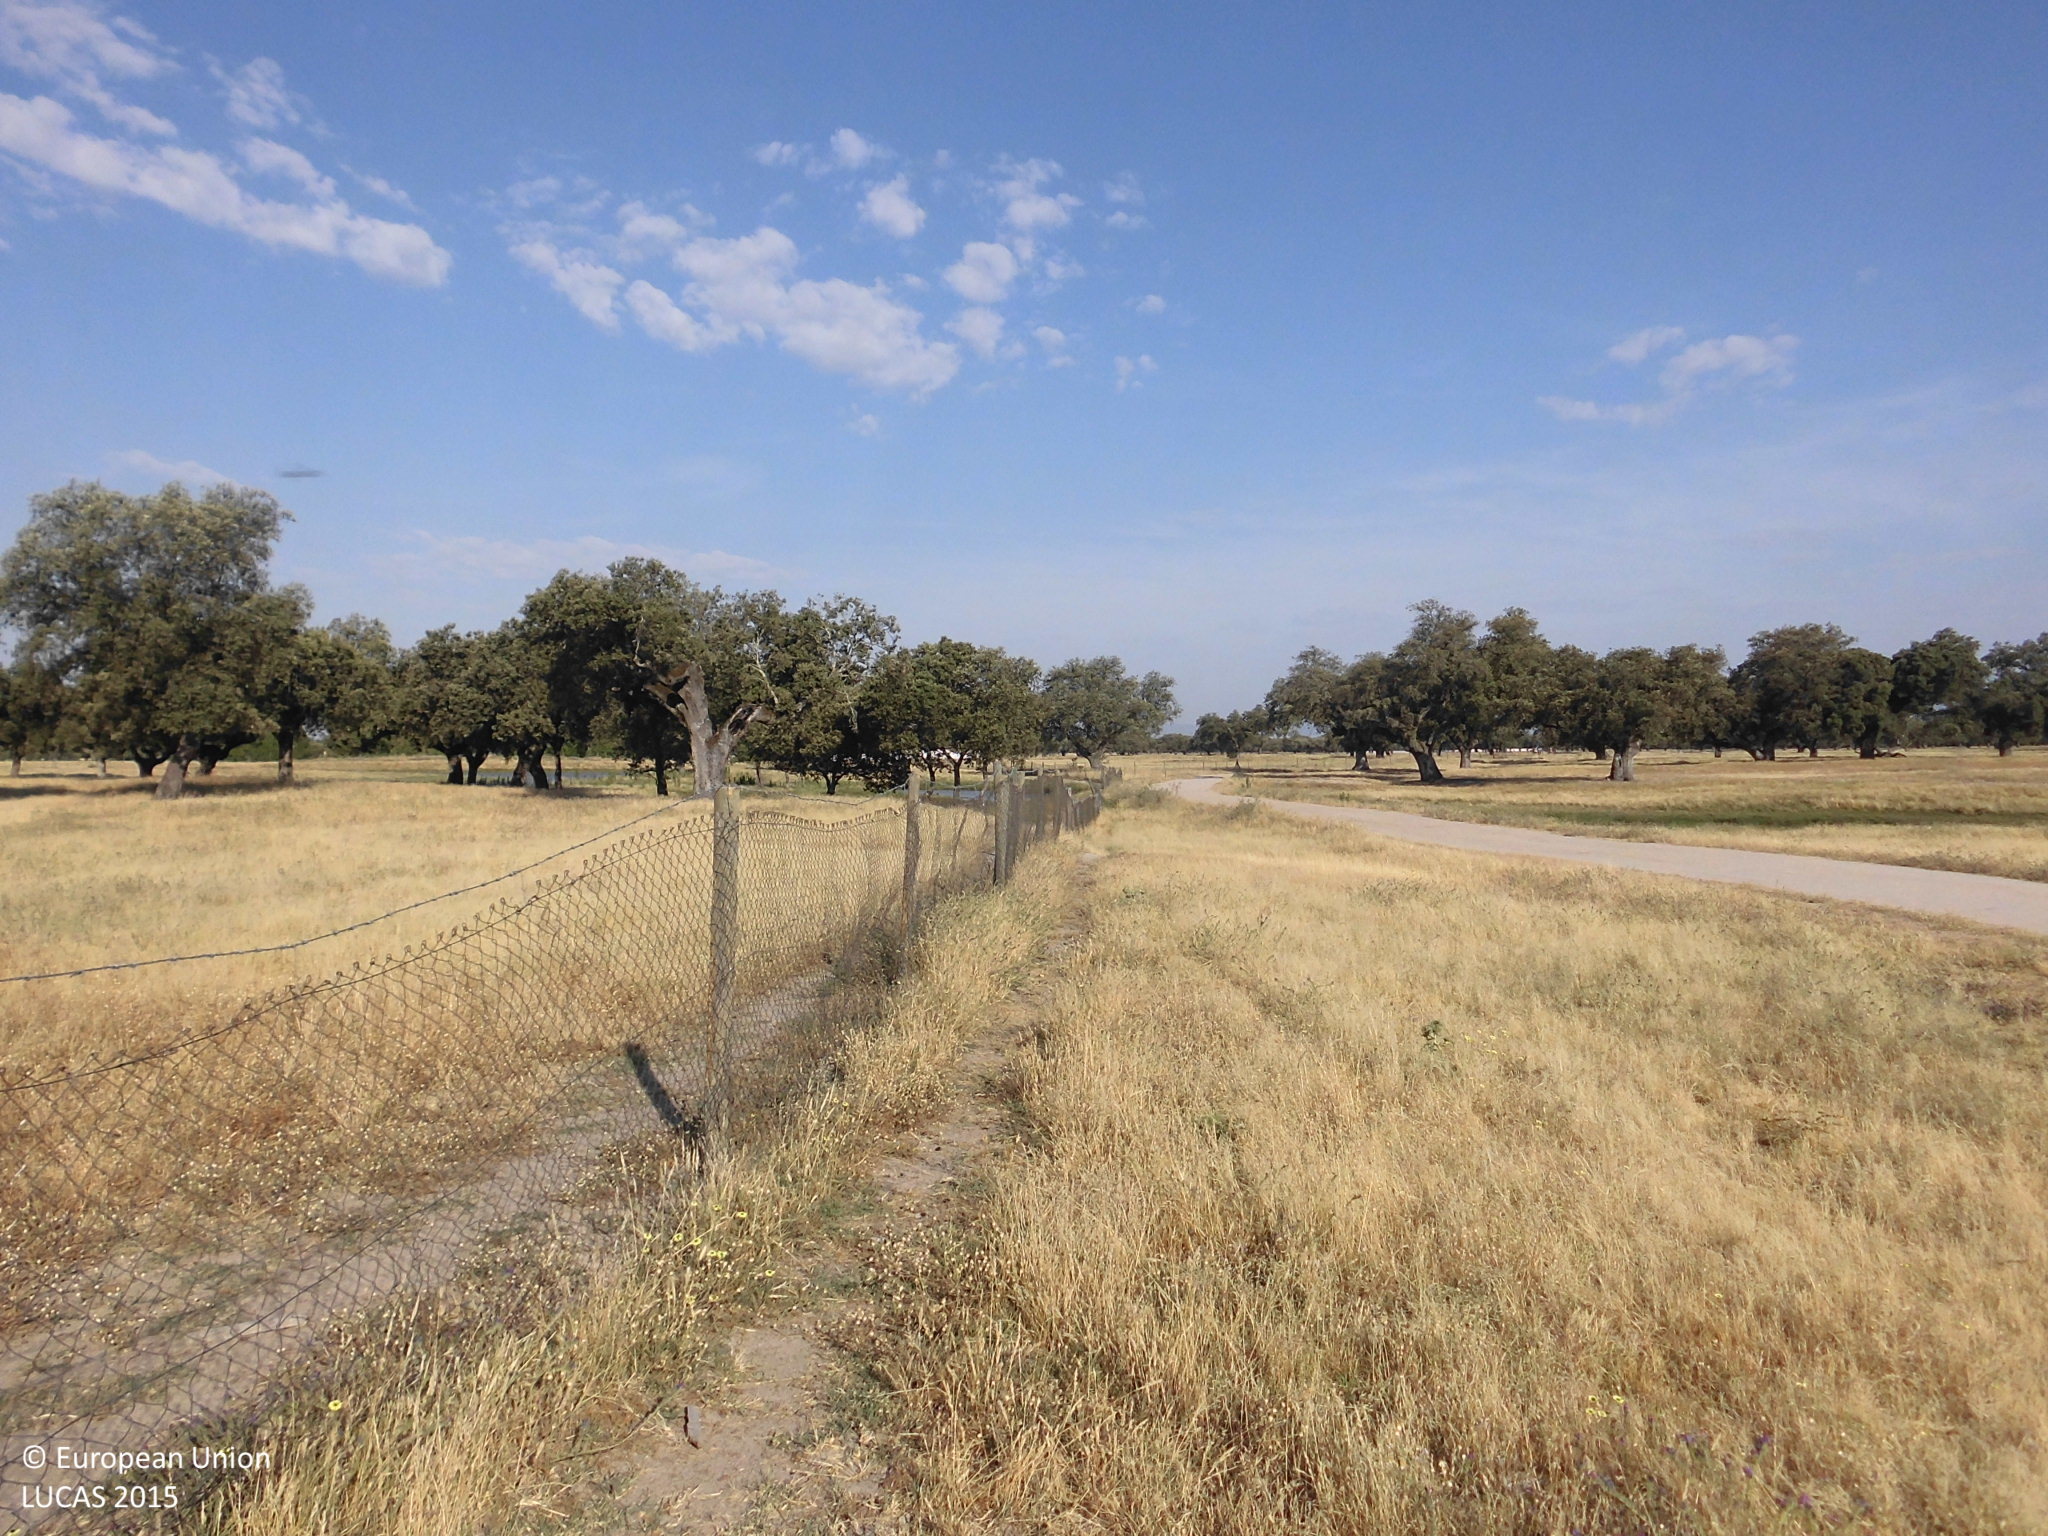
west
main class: Woodland
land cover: Broadleaved woodland
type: broadleaved evergreen forest
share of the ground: 25 - 50 %
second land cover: Grassland without tree/shrub cover
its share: > 75 %
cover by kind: herbaceous plants 70 %, broadleaved forest trees 30 %
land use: Forestry
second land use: Agriculture (excluding fallow land and kitchen gardens)
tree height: > 5 m
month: June
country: ES
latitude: 39.9578
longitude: -5.4279
